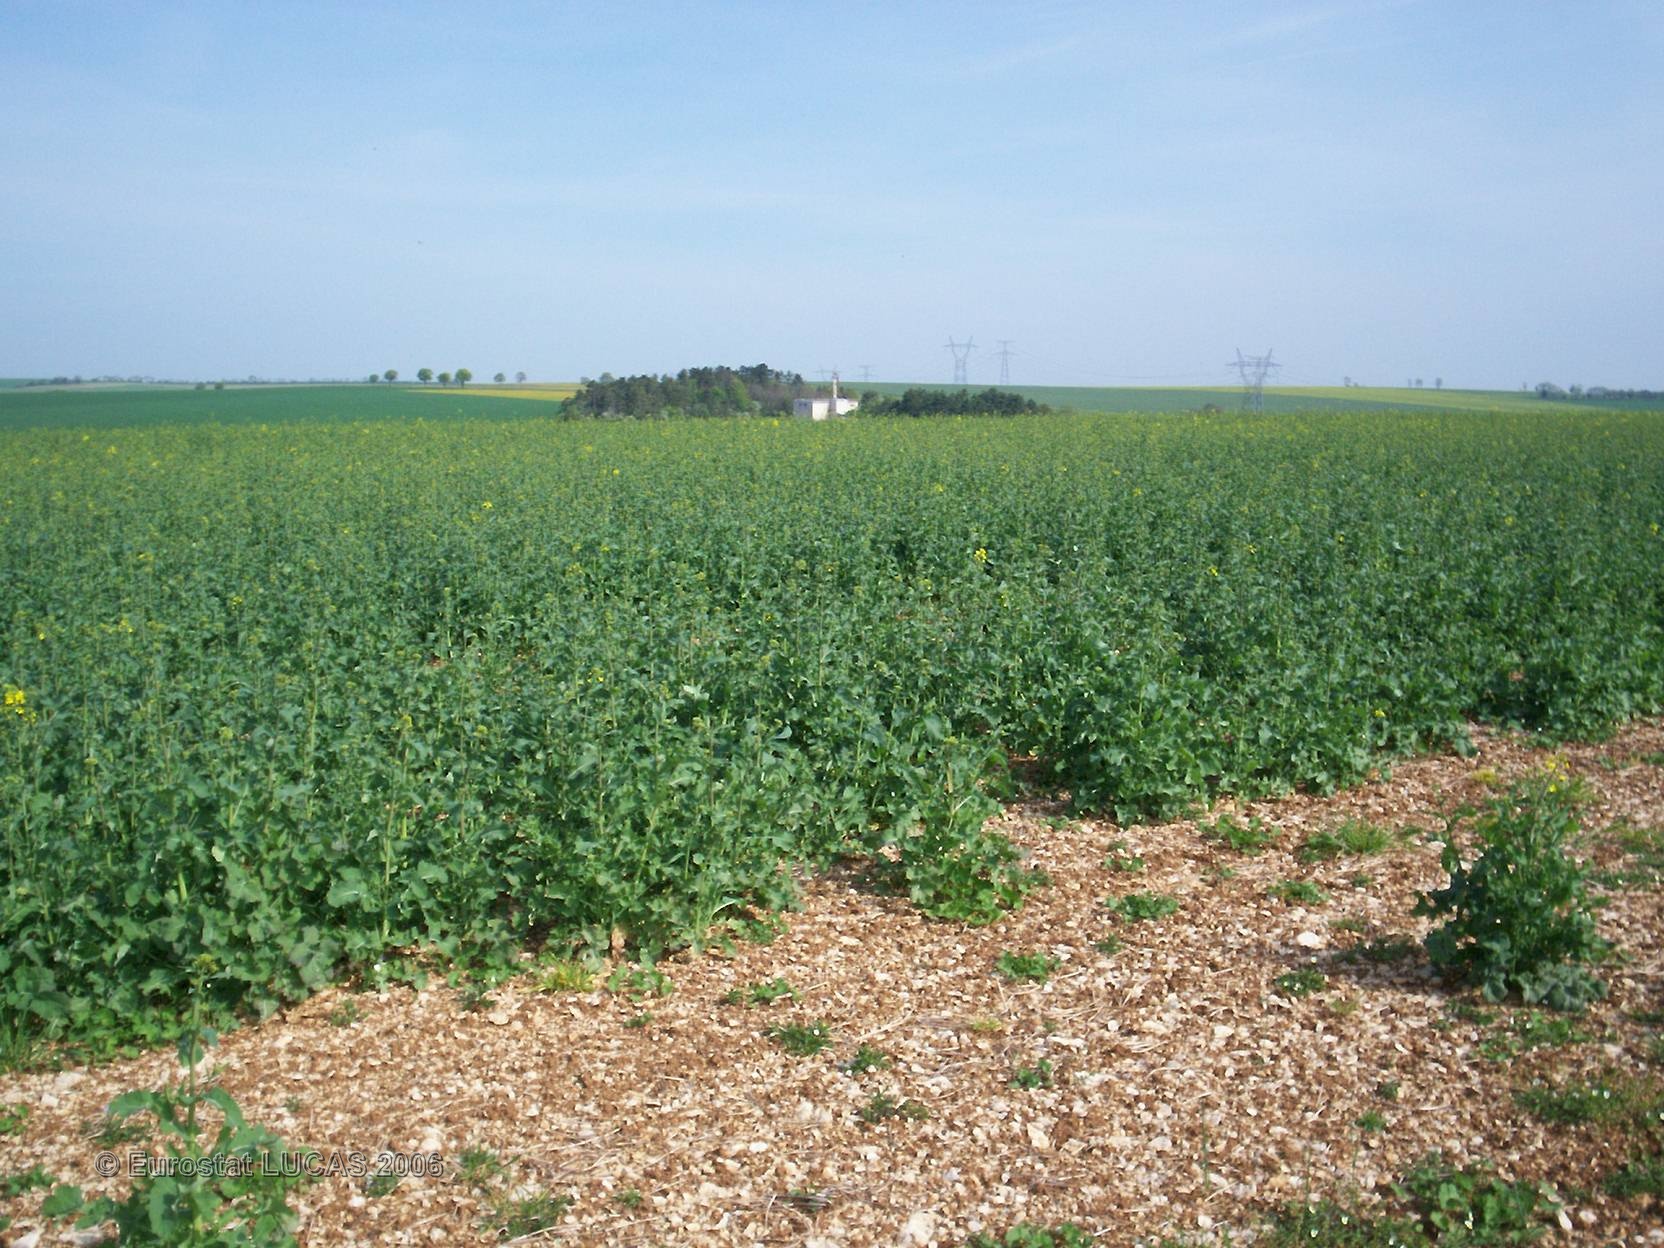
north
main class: Cropland
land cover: Rape and turnip rape
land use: Agriculture (excluding fallow land and kitchen gardens)
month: May
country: FR
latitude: 47.5843
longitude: 4.5608
